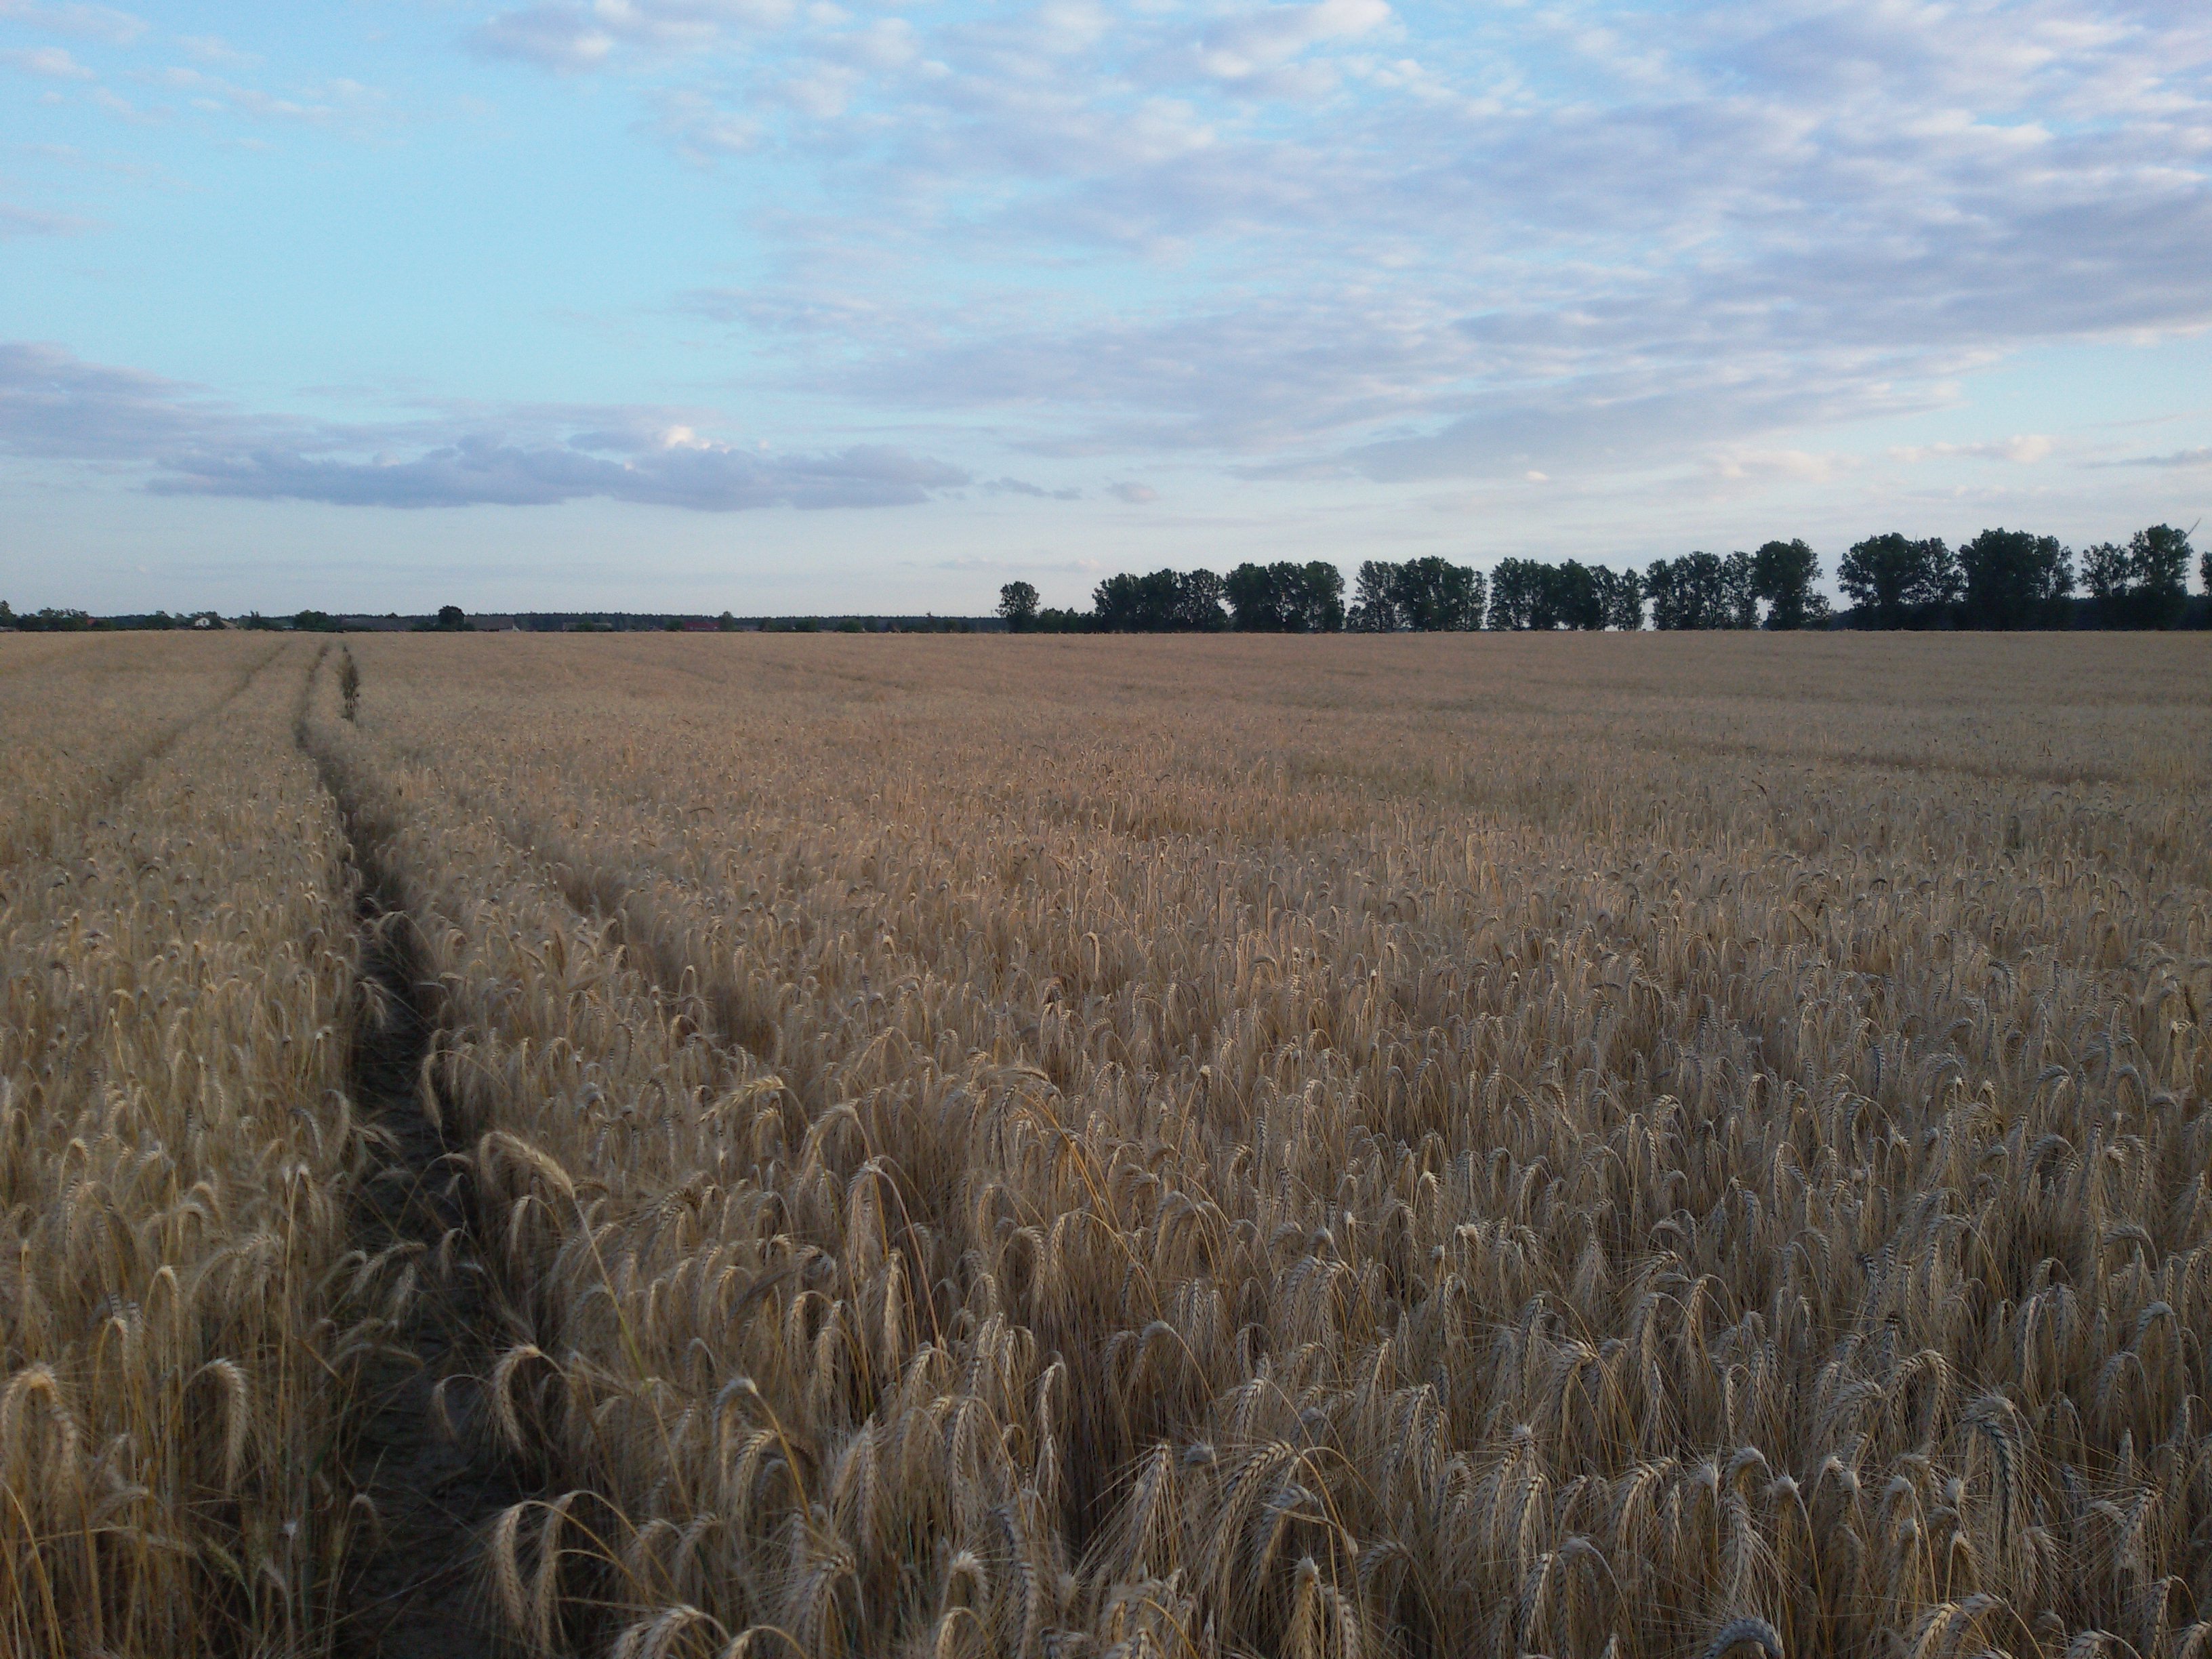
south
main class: Cropland
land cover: Triticale
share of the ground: > 75 %
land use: Agriculture (excluding fallow land and kitchen gardens)
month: July
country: PL
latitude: 52.8026
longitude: 16.9959
